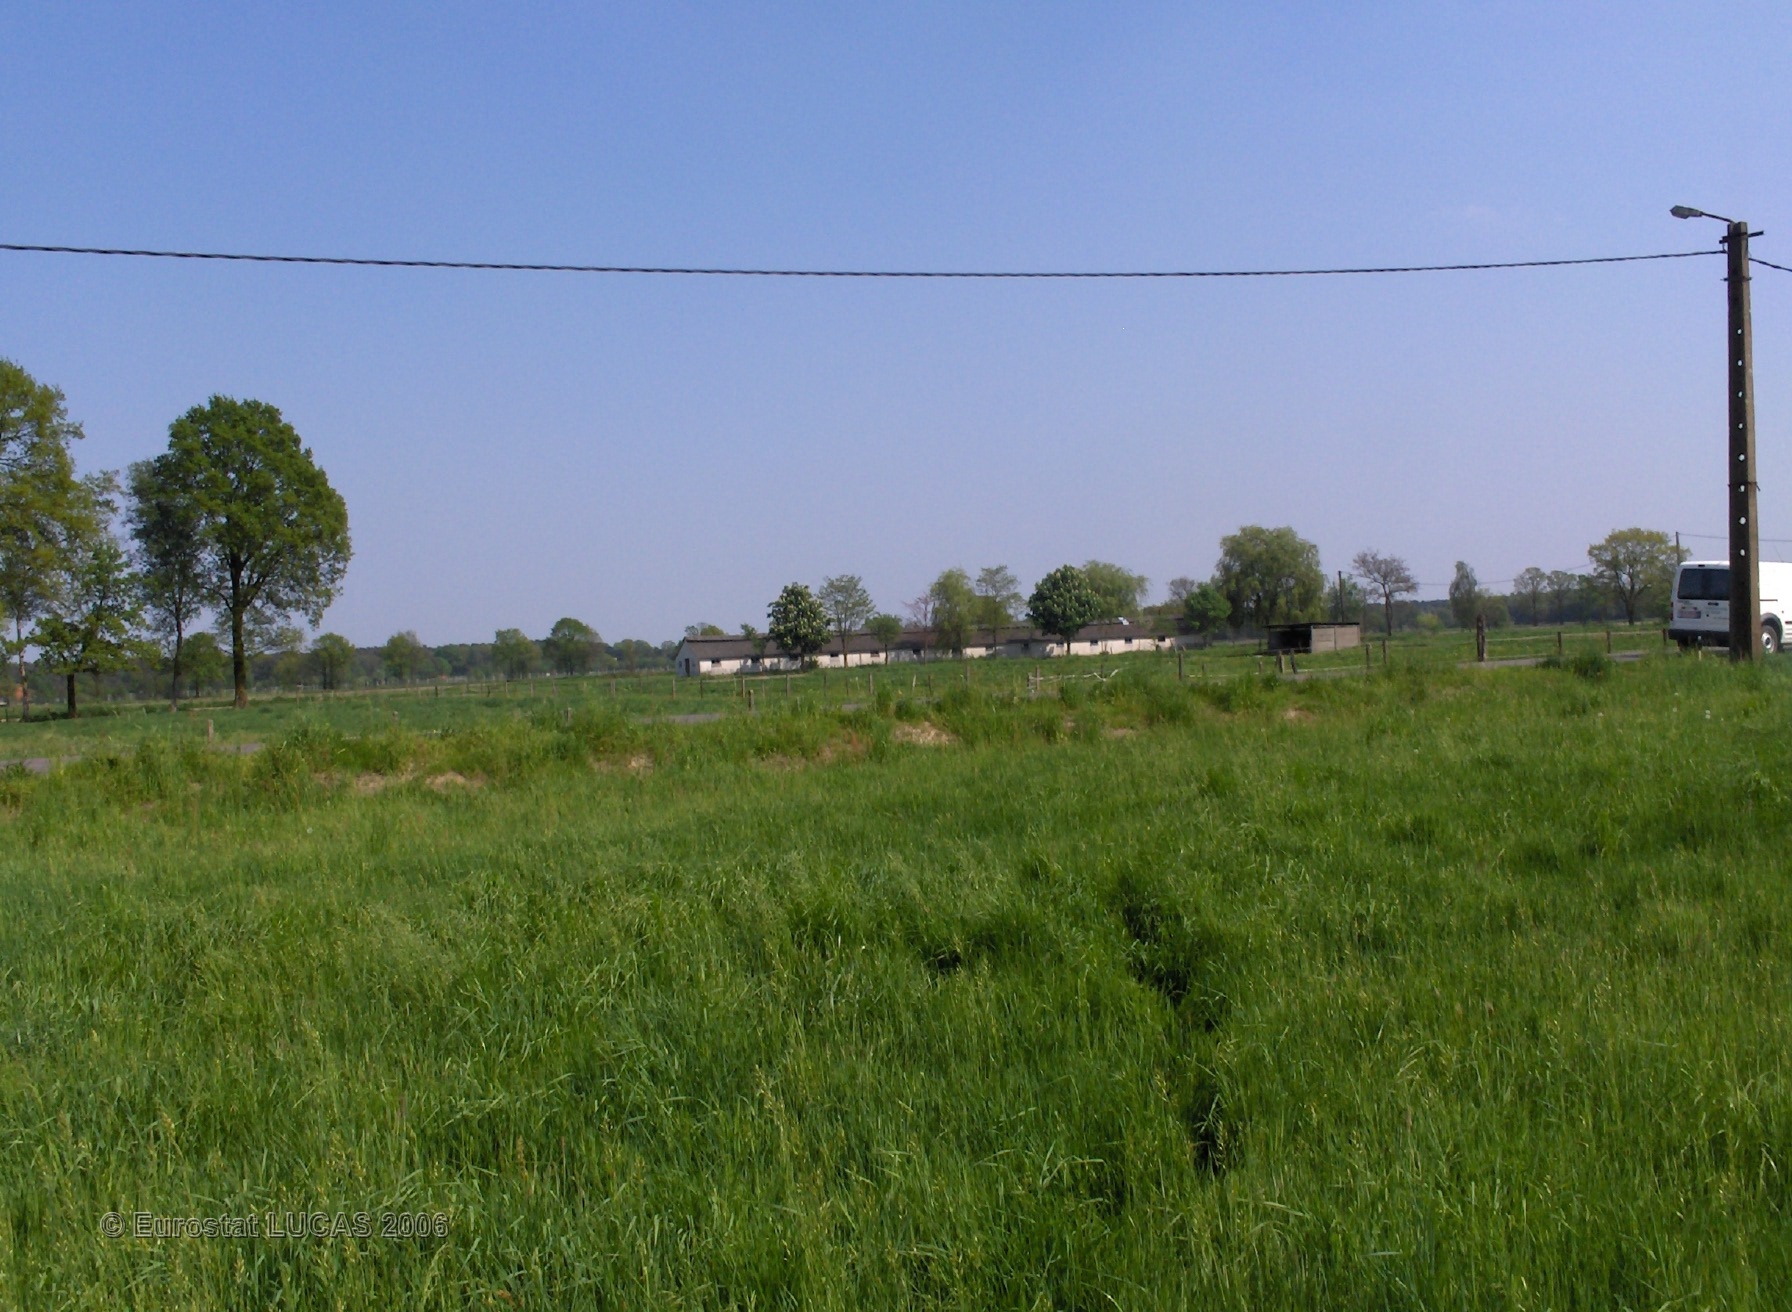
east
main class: Grassland
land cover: Grassland without tree/shrub cover
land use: Agriculture (excluding fallow land and kitchen gardens)
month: May
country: BE
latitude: 51.2515
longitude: 5.1404
